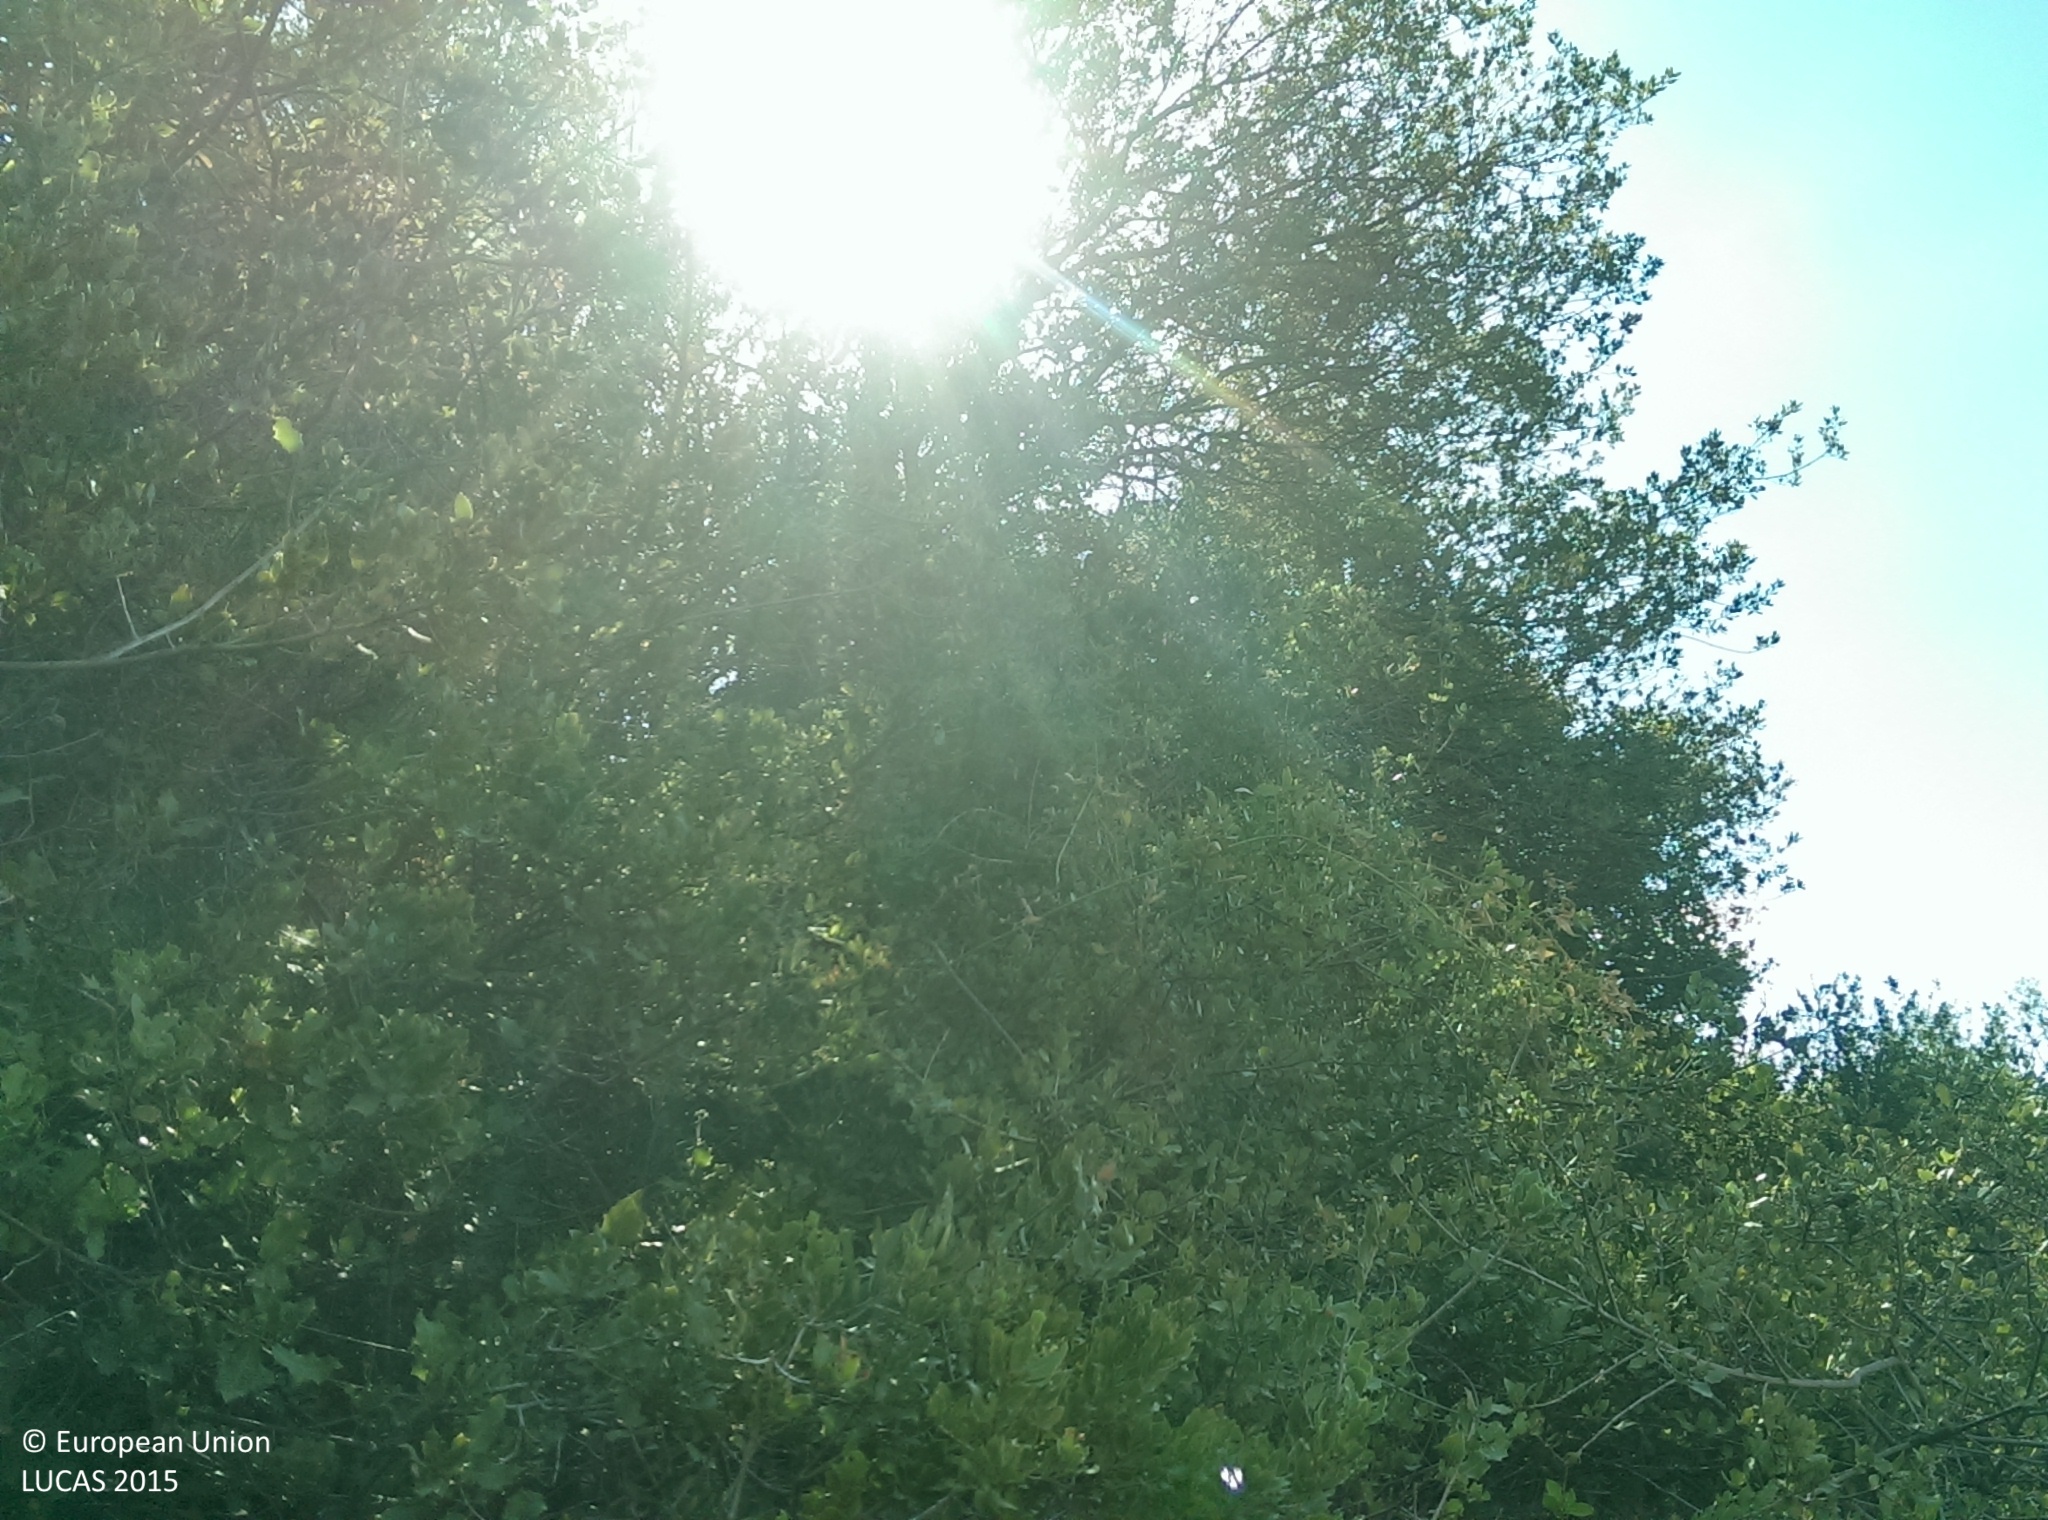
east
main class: Shrubland
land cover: Shrubland with sparse tree cover
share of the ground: > 75 %
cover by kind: shrubs 90 %, broadleaved forest trees 5 %, herbaceous plants 5 %
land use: Semi-natural and natural areas not in use
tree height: > 5 m
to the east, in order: Shrubland with sparse tree cover; Rivers and streams; Shrubland with sparse tree cover; Olive groves; Shrubland with sparse tree cover; Nuts trees; Shrubland with sparse tree cover; Nuts trees; Shrubland with sparse tree cover
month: August
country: ES
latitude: 36.8388
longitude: -3.0879
